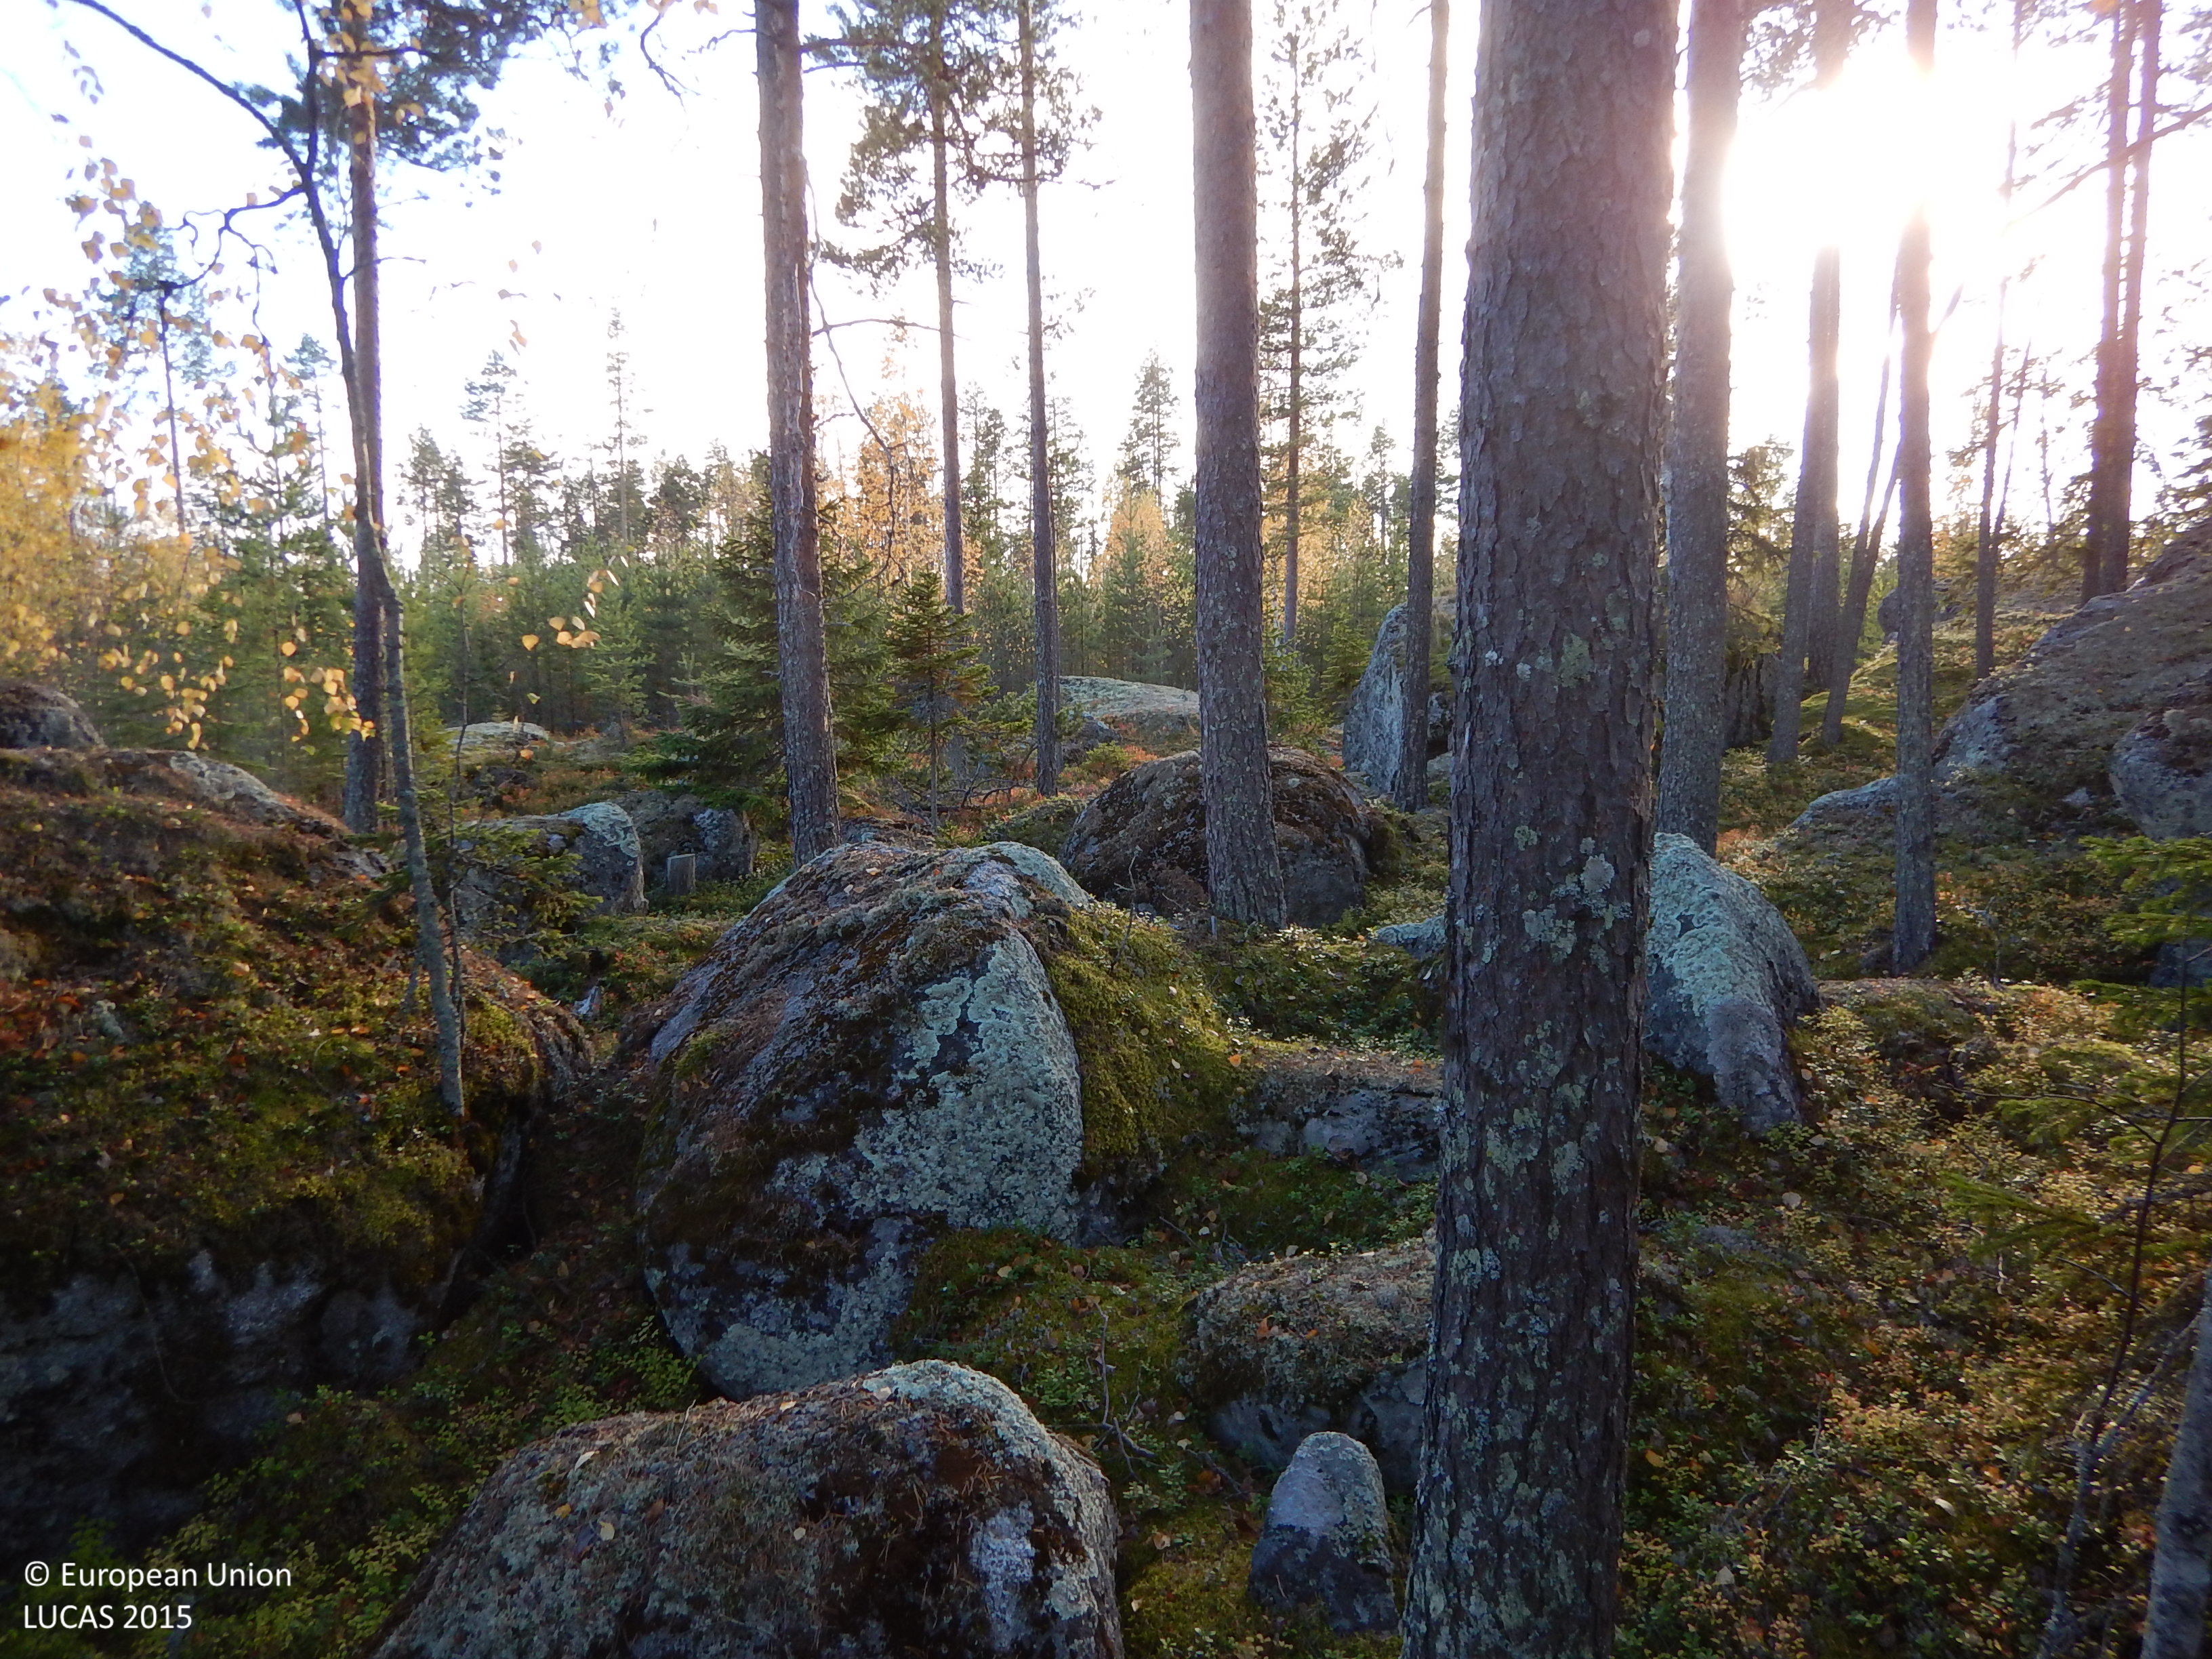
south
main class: Woodland
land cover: Other coniferous woodland
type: boreal forest
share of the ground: 50 - 75 %
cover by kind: coniferous forest trees 50 %, shrubs 20 %, lichens and mosses 20 %, herbaceous plants 5 %, consolidated bare surface 5 %
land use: Forestry
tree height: > 5 m
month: October
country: SE
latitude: 64.9167
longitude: 20.9057
